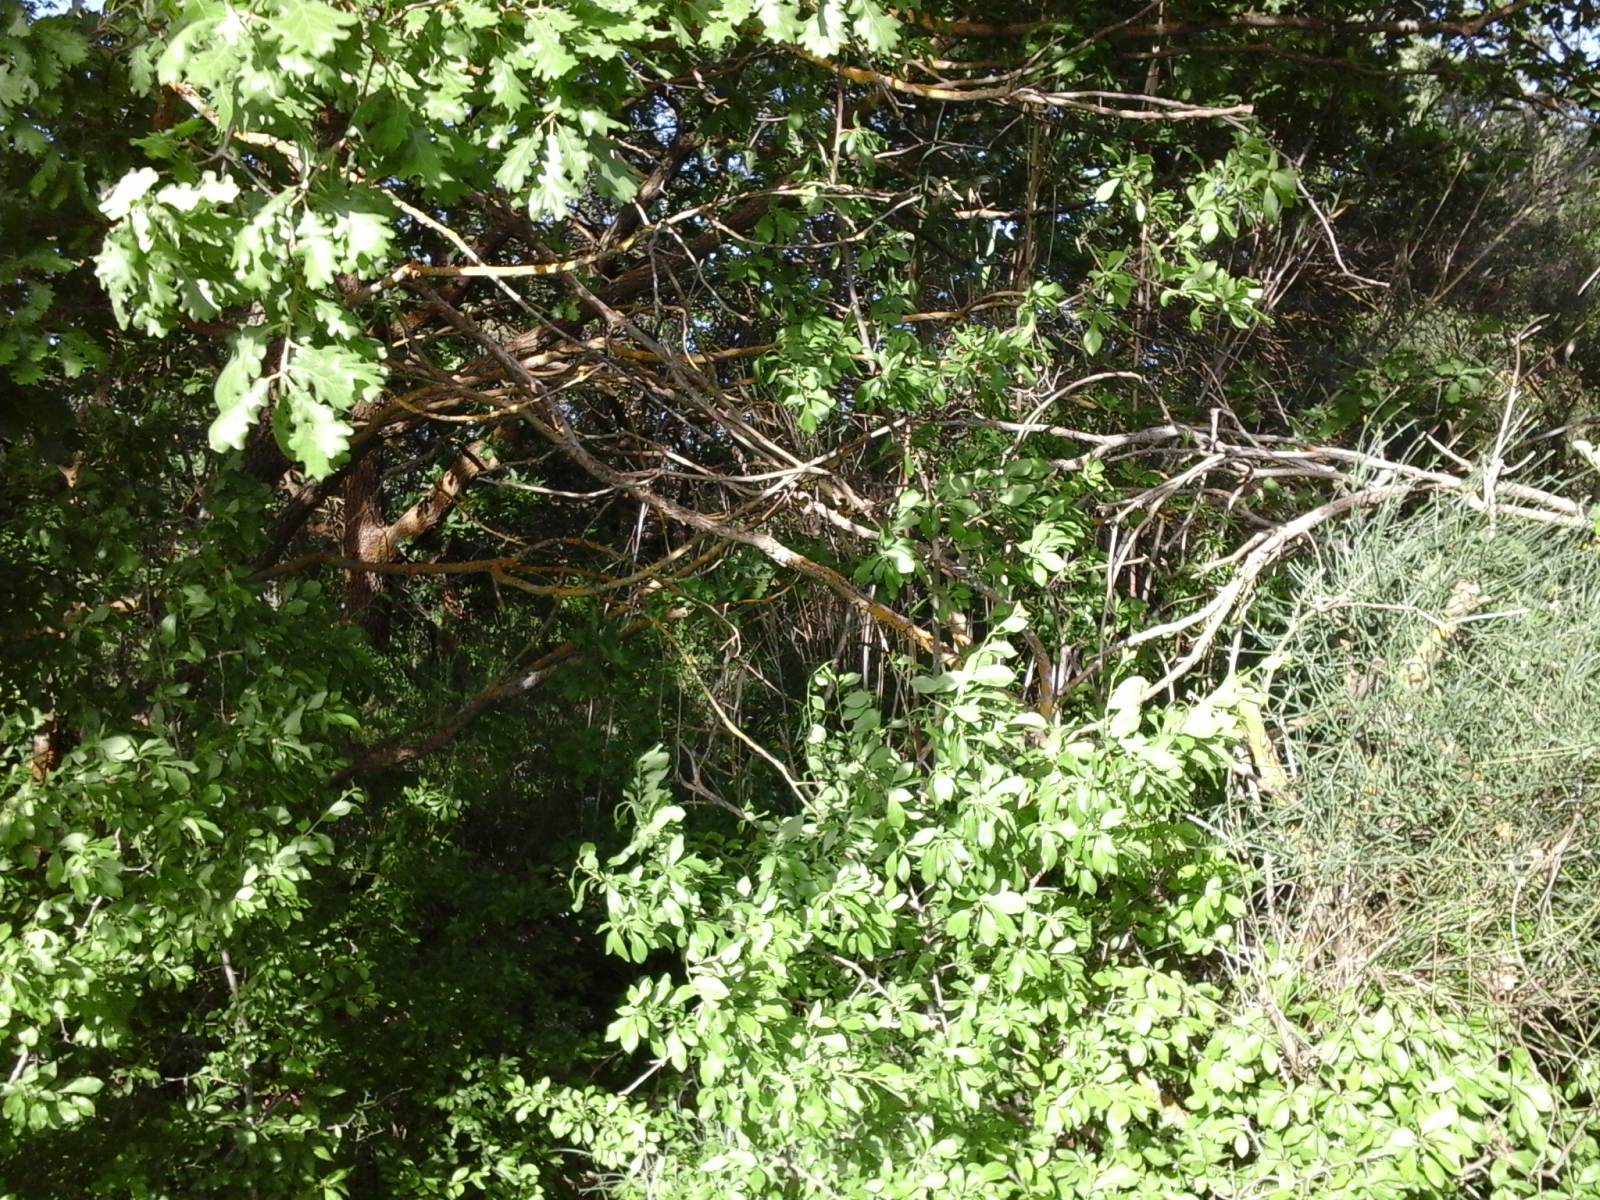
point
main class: Woodland
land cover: Broadleaved woodland
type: broadleaved evergreen forest
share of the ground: > 75 %
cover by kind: broadleaved forest trees 70 %, shrubs 20 %, coniferous forest trees 10 %
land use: Forestry
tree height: > 5 m
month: May
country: IT
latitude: 37.4985
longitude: 14.0306
